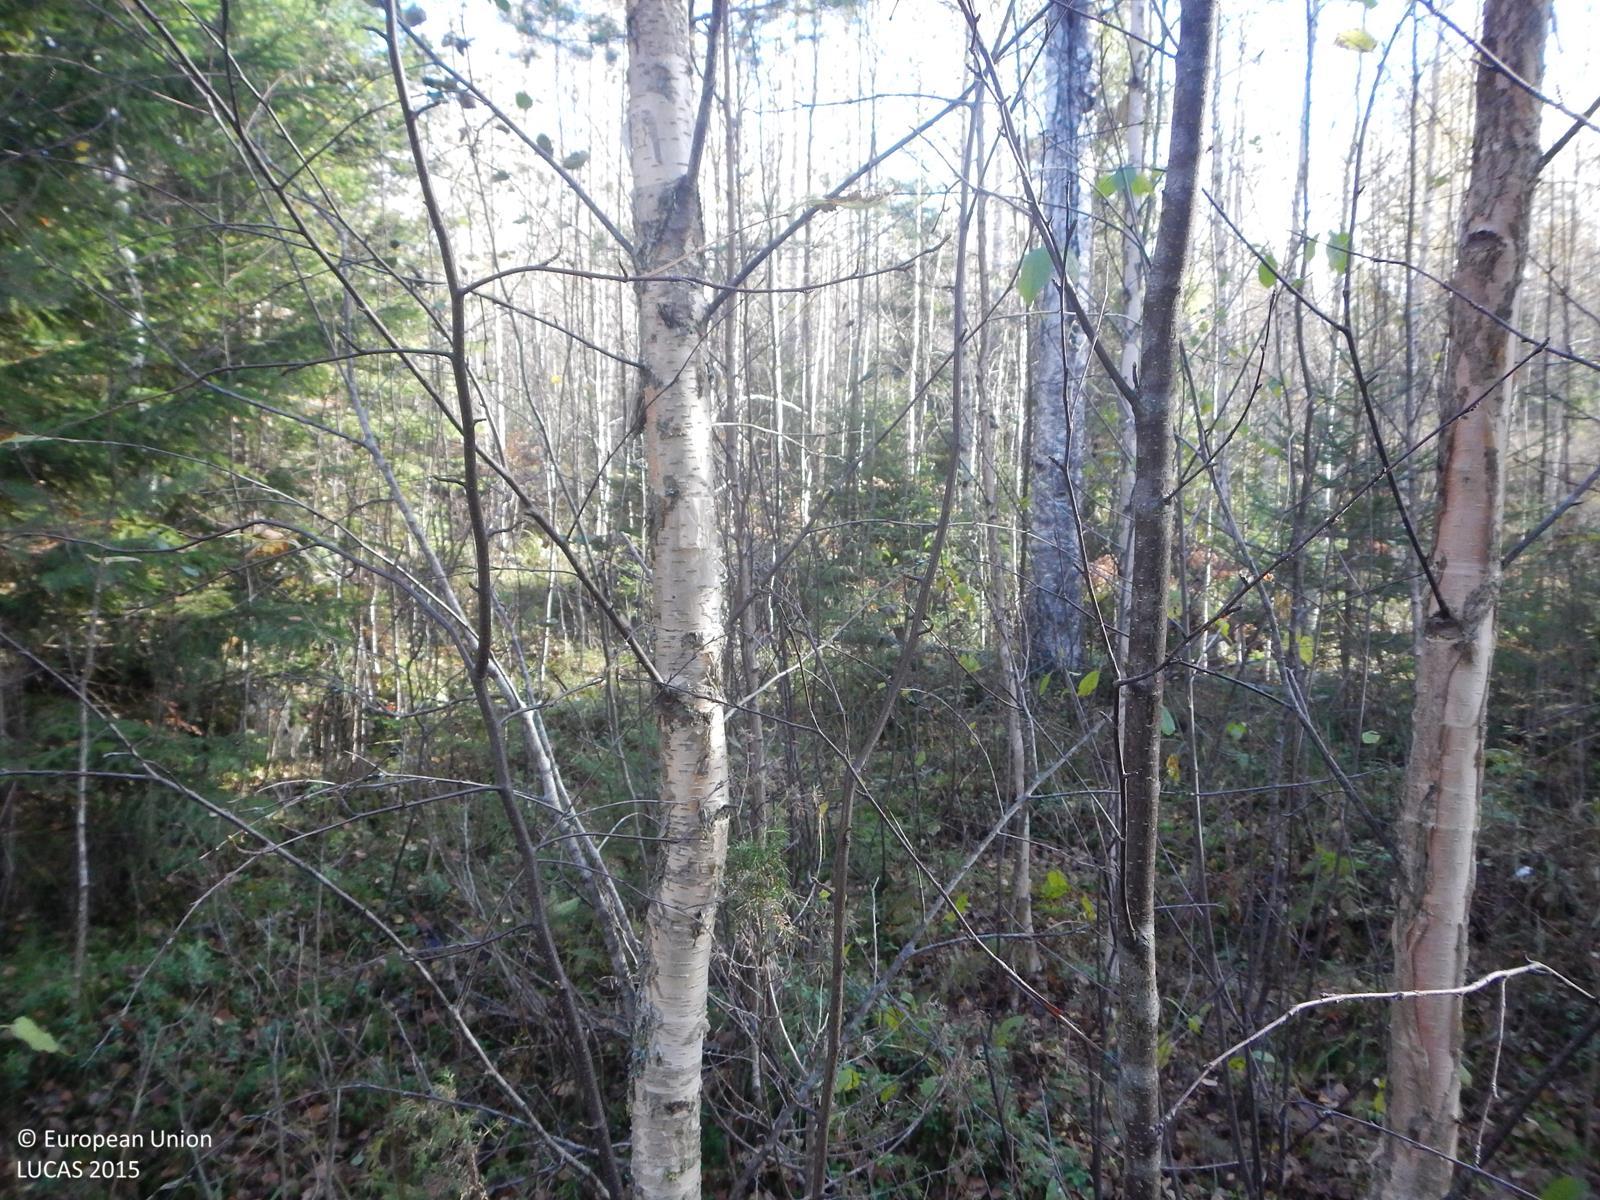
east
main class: Woodland
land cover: Spruce dominated mixed woodland
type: boreal forest
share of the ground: > 75 %
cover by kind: broadleaved forest trees 60 %, coniferous forest trees 30 %, shrubs 5 %, herbaceous plants 5 %
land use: Forestry
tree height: > 5 m
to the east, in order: Spruce dominated mixed woodland; Broadleaved woodland; Spruce dominated mixed woodland; Spruce dominated coniferous woodland; Shrubland with sparse tree cover; Electric lines; Shrubland with sparse tree cover; Spruce dominated coniferous woodland
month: October
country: FI
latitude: 61.6357
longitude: 25.8464
